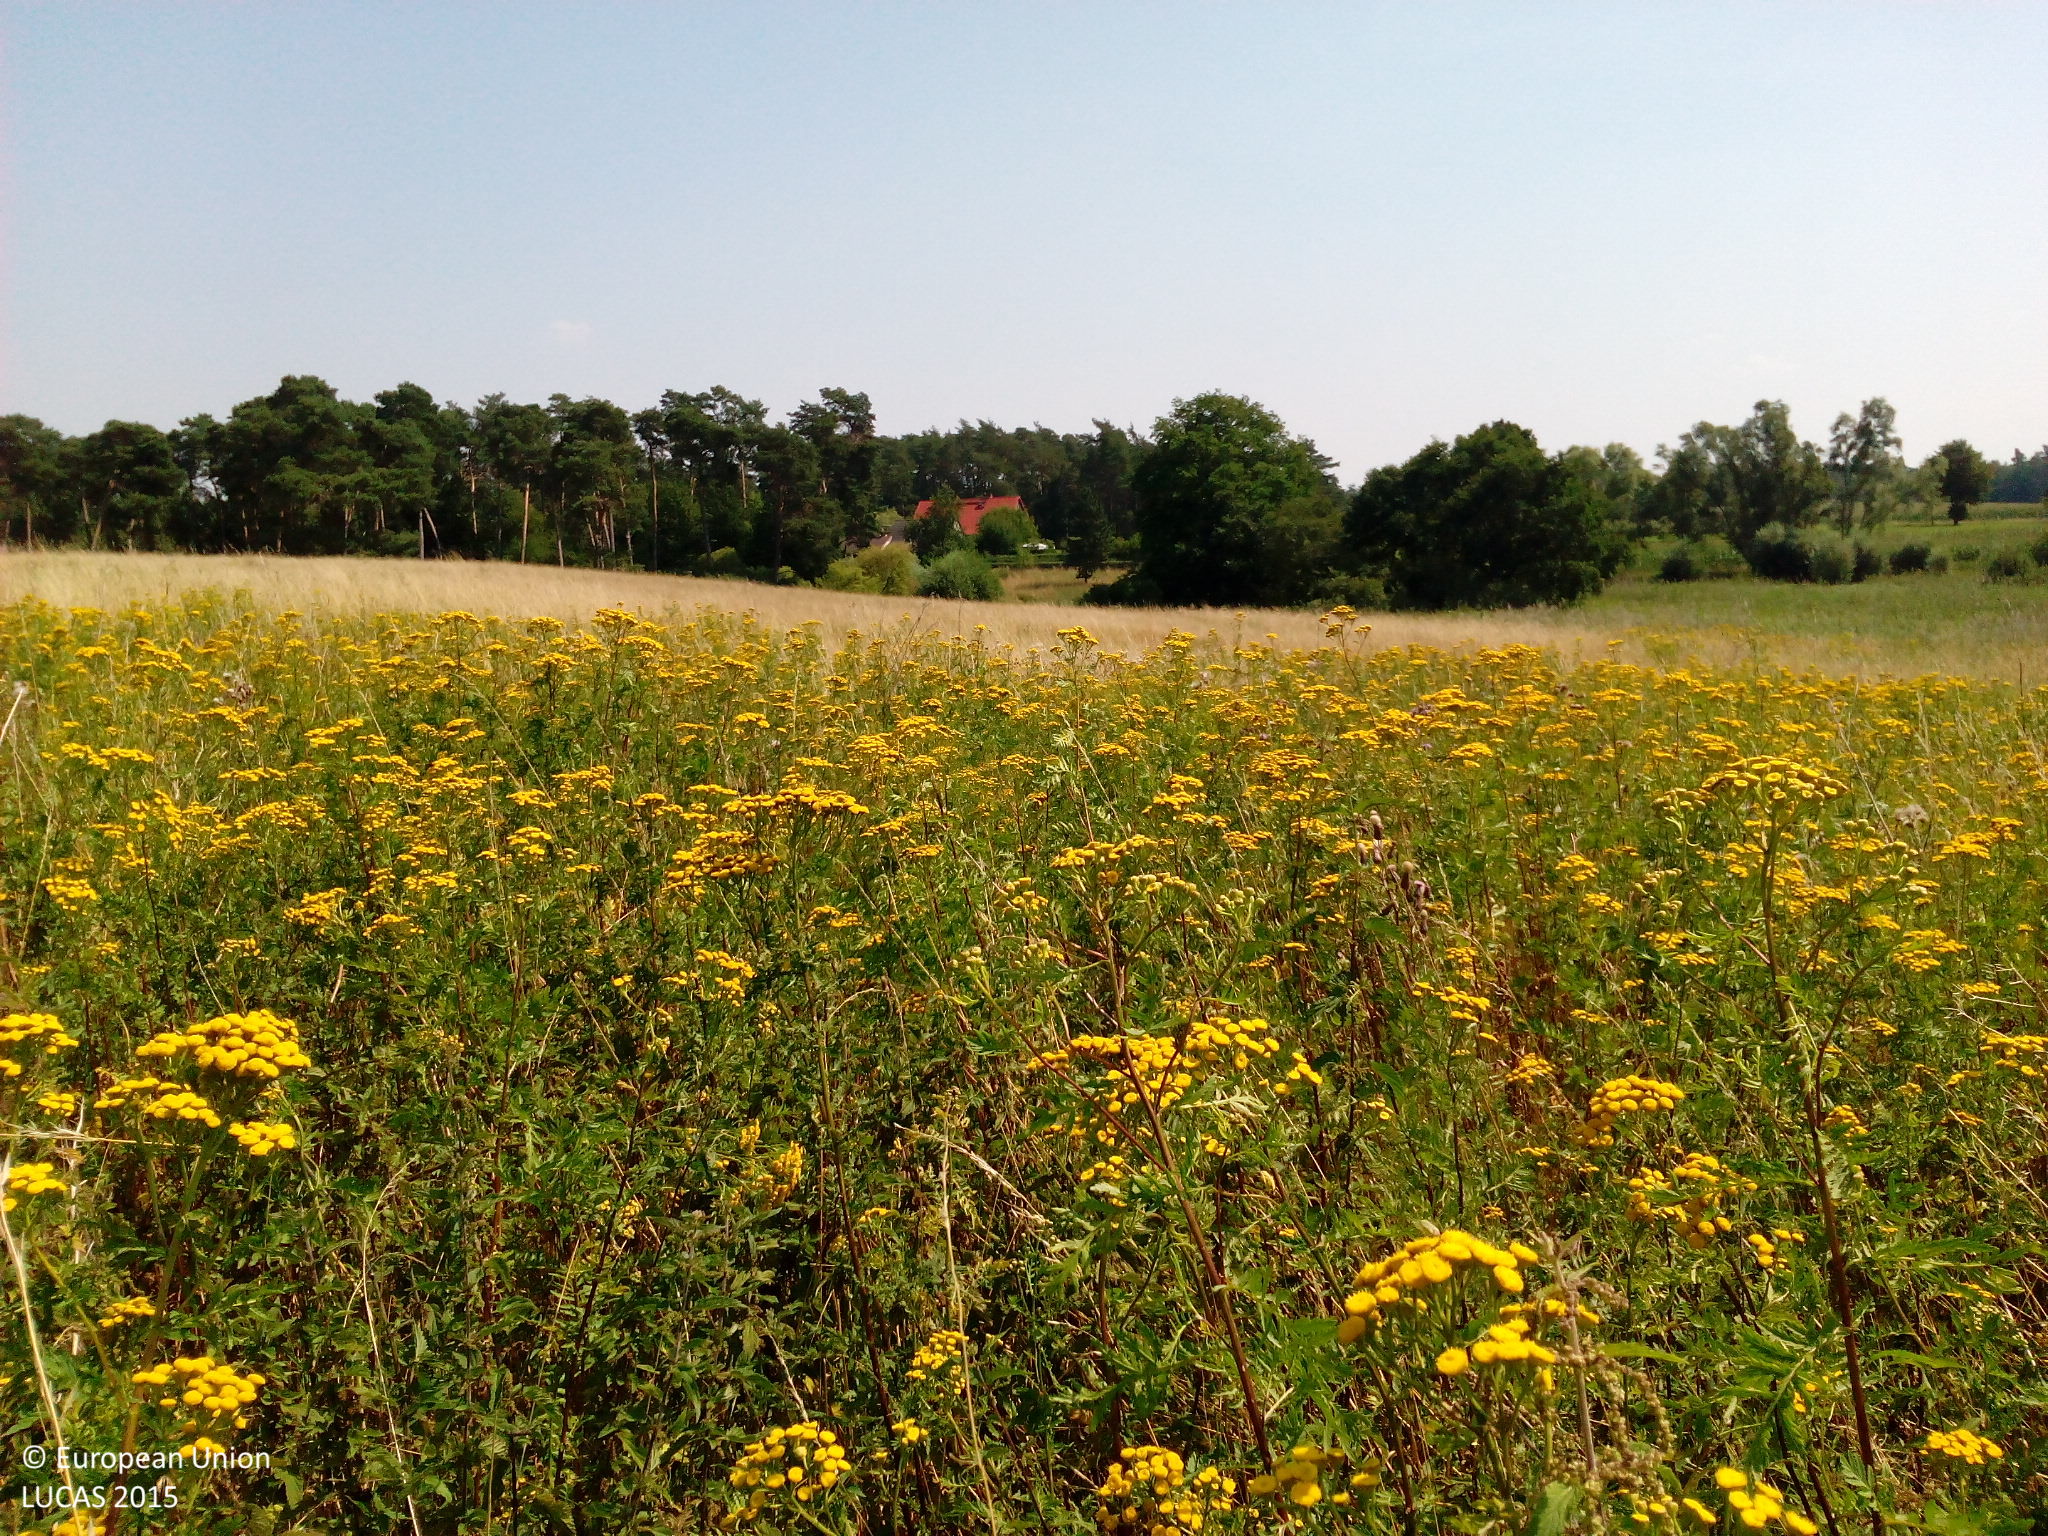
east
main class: Grassland
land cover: Spontaneously vegetated surfaces
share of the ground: > 75 %
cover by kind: herbaceous plants 100 %
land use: Fallow land
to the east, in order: Spontaneously vegetated surfaces; Grassland without tree/shrub cover; Tracks; Pine dominated coniferous woodland; Grassland with sparse tree/shrub cover; Tracks; Grassland with sparse tree/shrub cover; Grass margins; Artificial constructions in urban areas
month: August
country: DE
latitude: 53.3308
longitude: 13.5887
